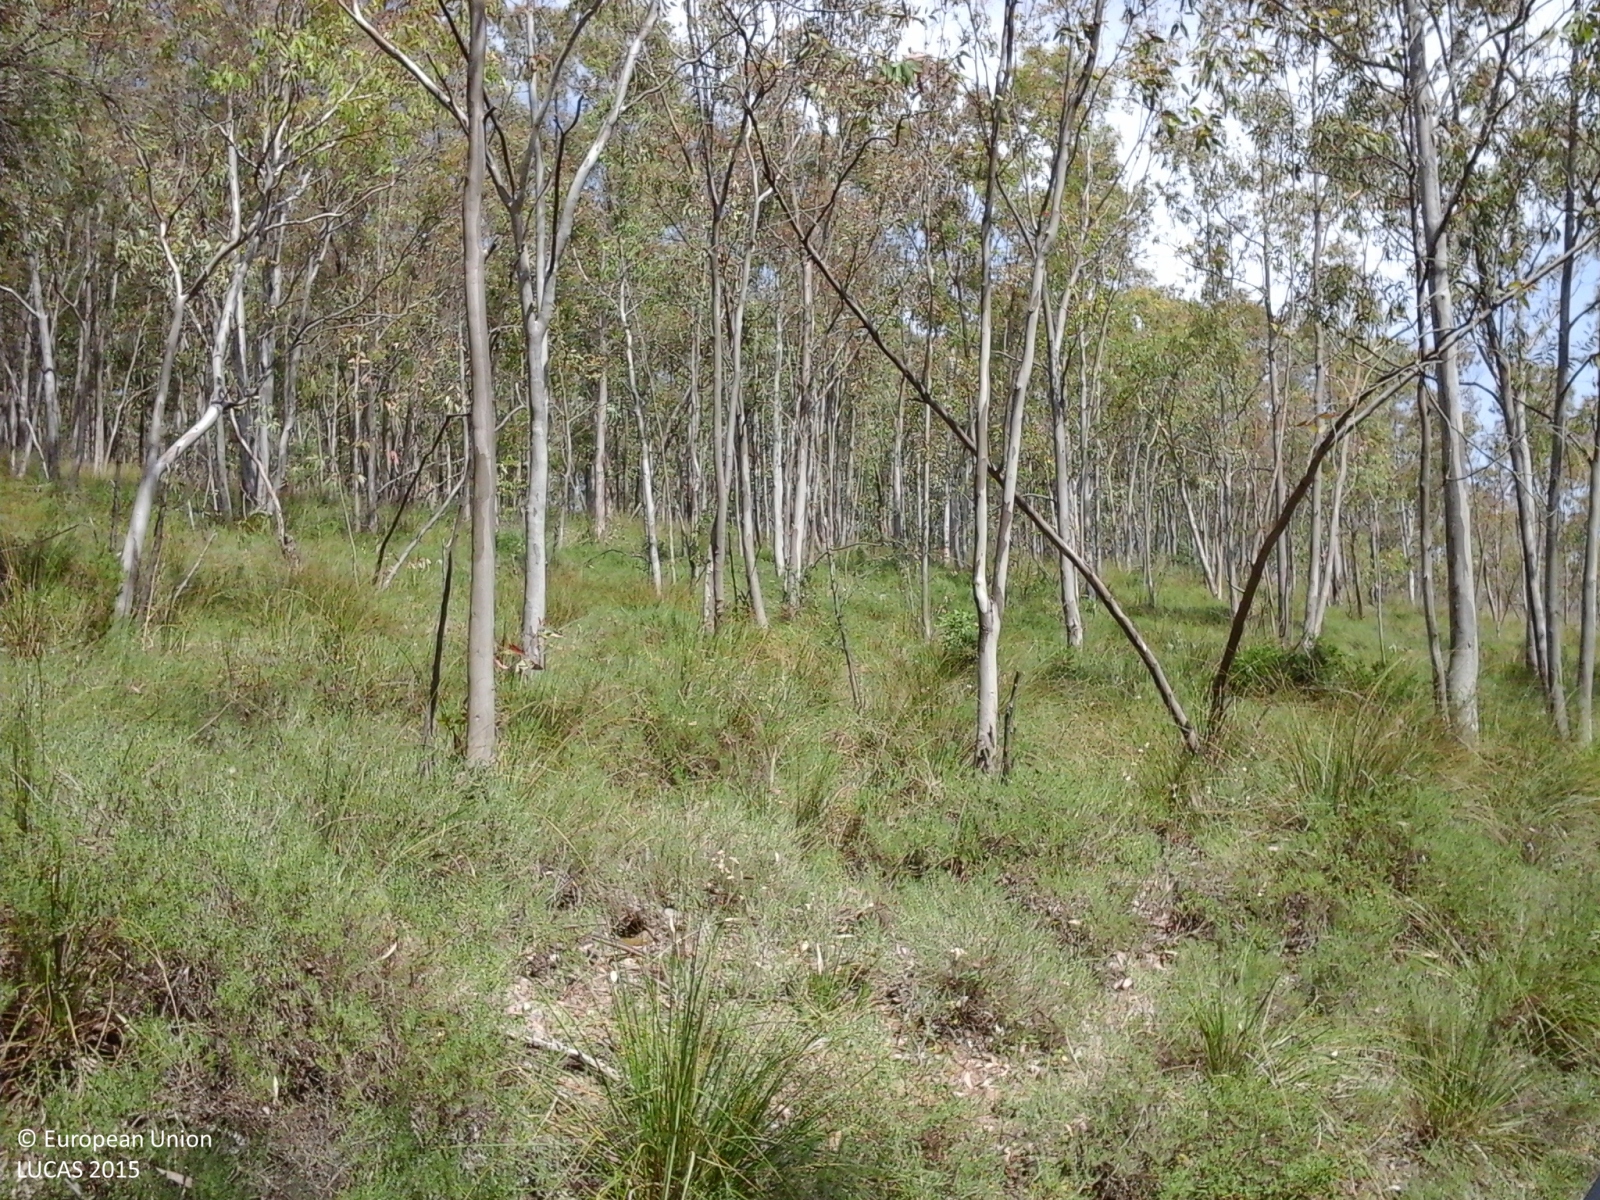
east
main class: Woodland
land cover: Broadleaved woodland
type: exotic forest
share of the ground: > 75 %
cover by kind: broadleaved forest trees 100 %
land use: Forestry
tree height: > 5 m
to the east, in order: Broadleaved woodland
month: May
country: IT
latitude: 37.3194
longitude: 14.3790
